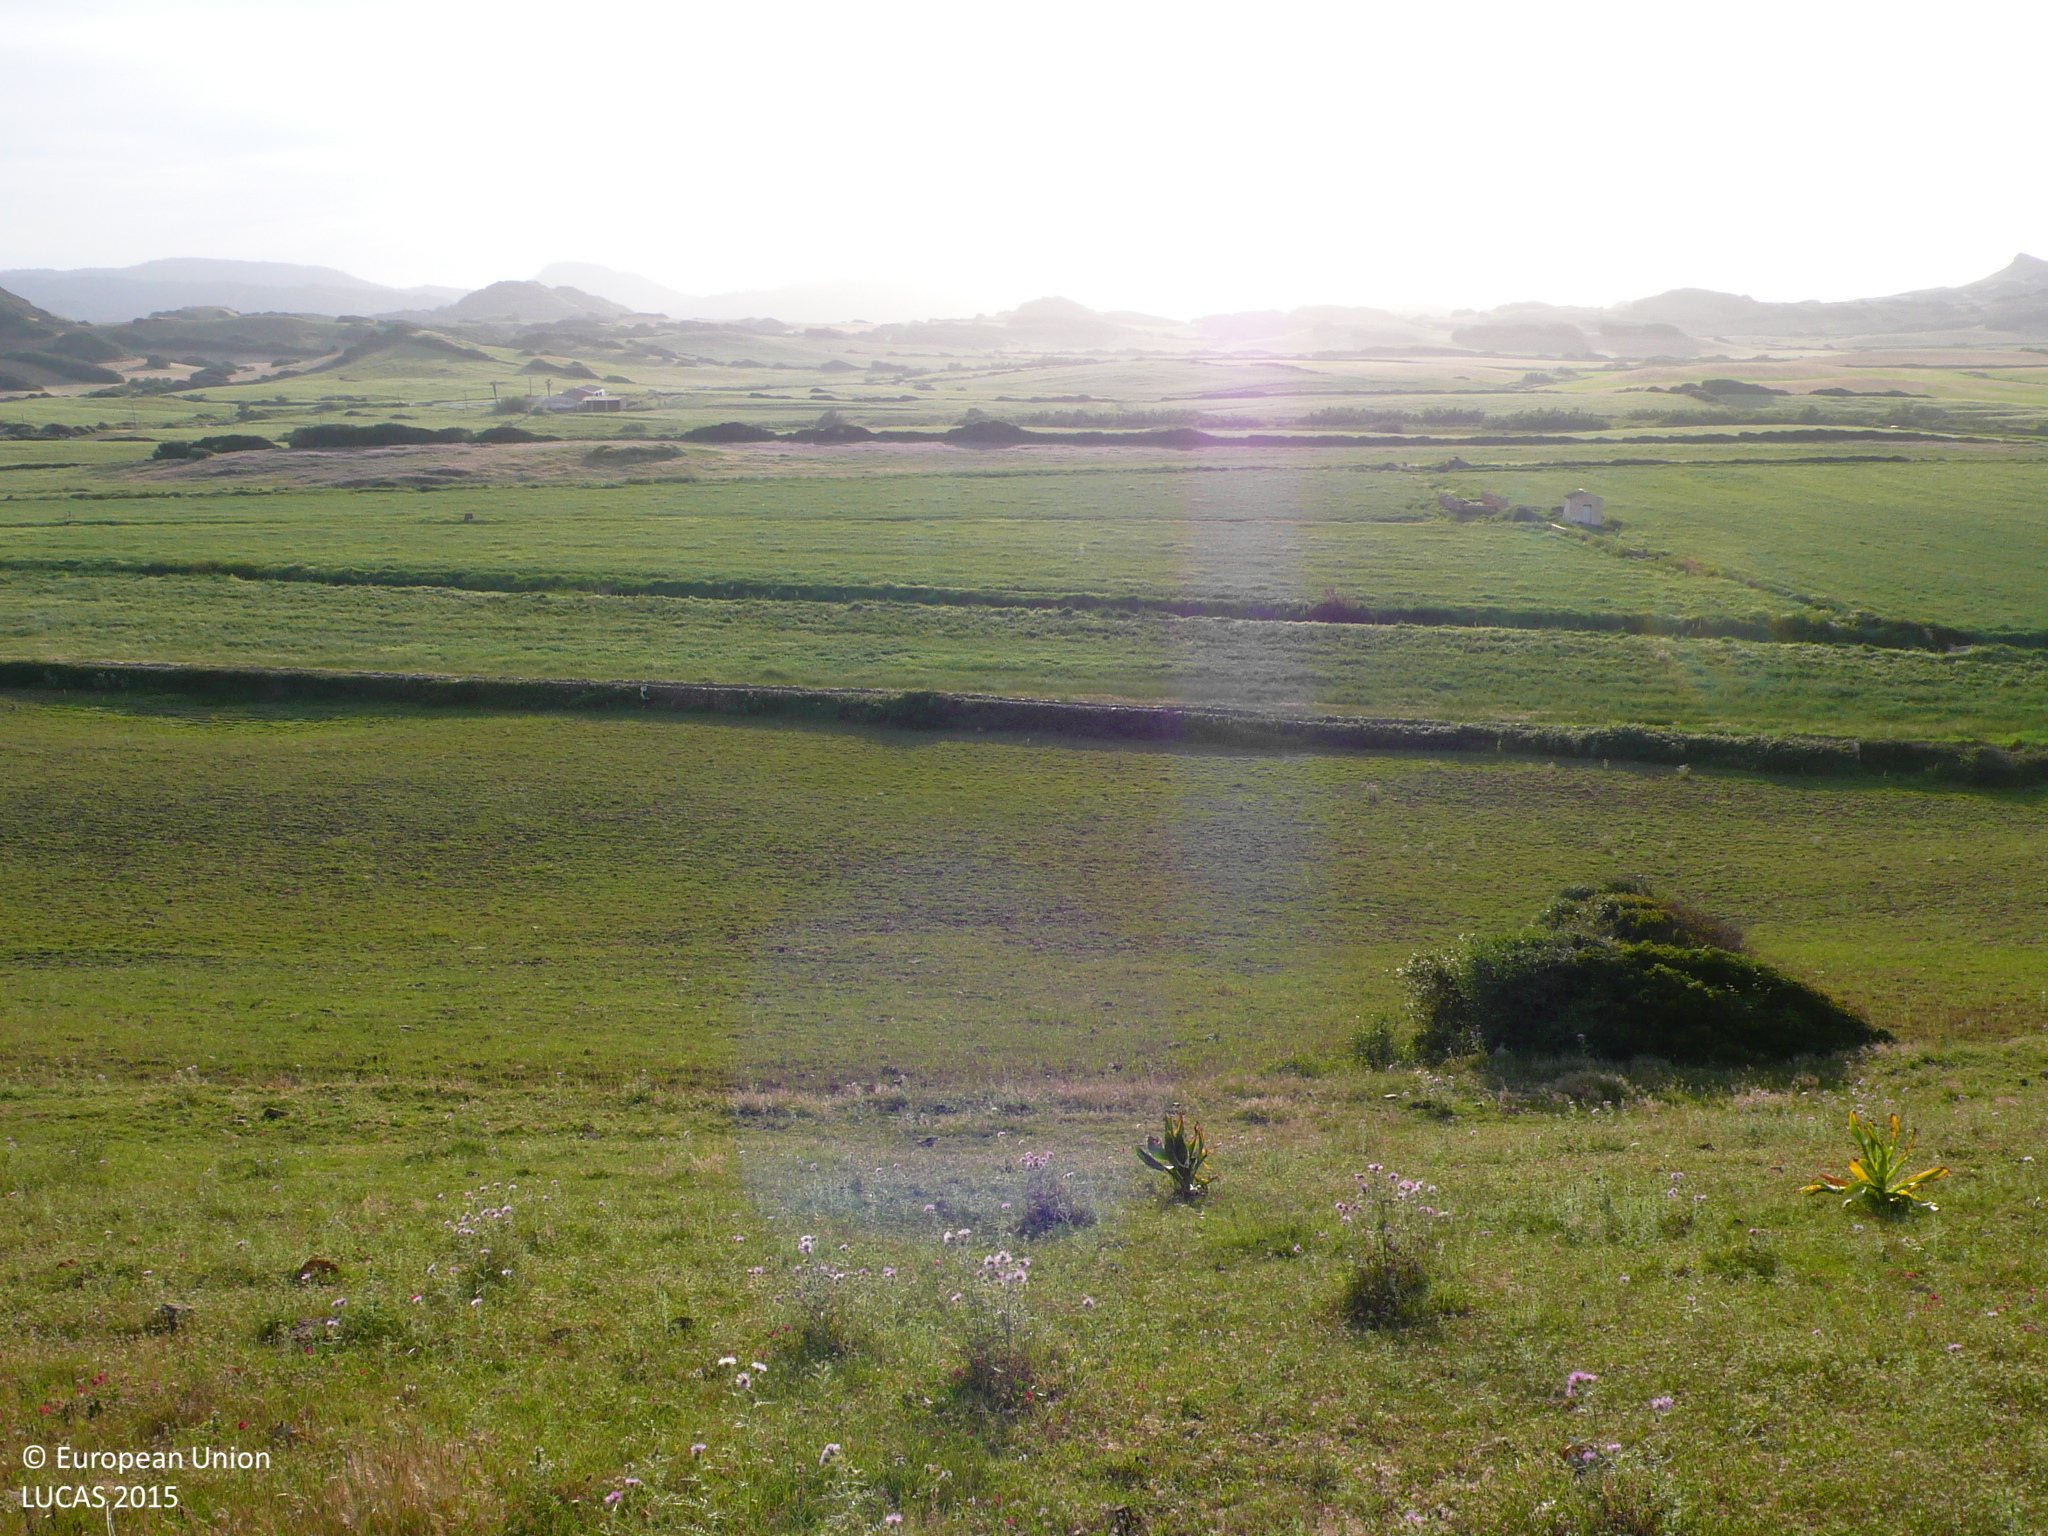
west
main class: Grassland
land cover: Grassland with sparse tree/shrub cover
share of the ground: > 75 %
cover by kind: herbaceous plants 85 %, broadleaved forest trees 5 %, shrubs 5 %, consolidated bare surface 5 %
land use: Agriculture (excluding fallow land and kitchen gardens)
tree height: < 5 m
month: May
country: ES
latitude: 40.0343
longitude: 4.0841
